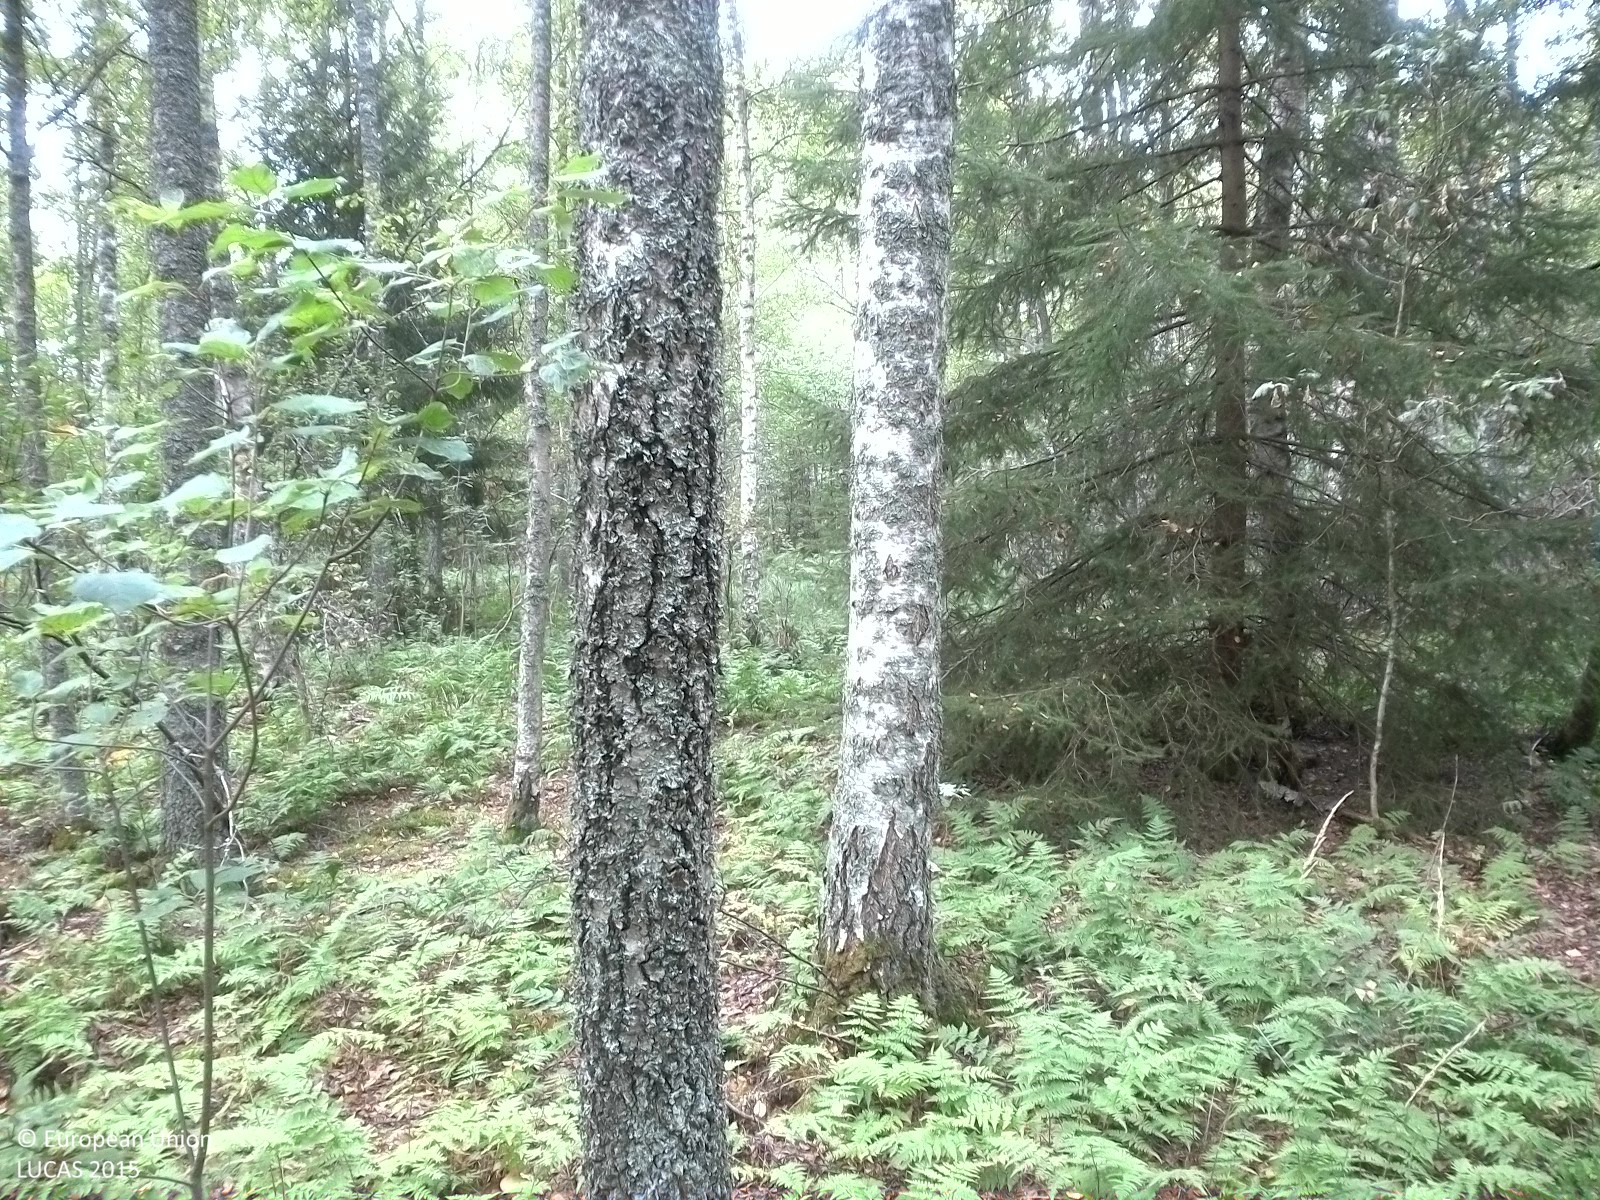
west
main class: Woodland
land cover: Broadleaved woodland
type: hemiboreal forest and nemoral coniferous forest and mixed broadleaved-coniferous forest
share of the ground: 25 - 50 %
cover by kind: broadleaved forest trees 35 %, herbaceous plants 35 %, unconsolidated bare surface 20 %, coniferous forest trees 5 %, lichens and mosses 5 %
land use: Forestry
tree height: > 5 m
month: August
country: SE
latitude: 59.3001
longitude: 15.8749
